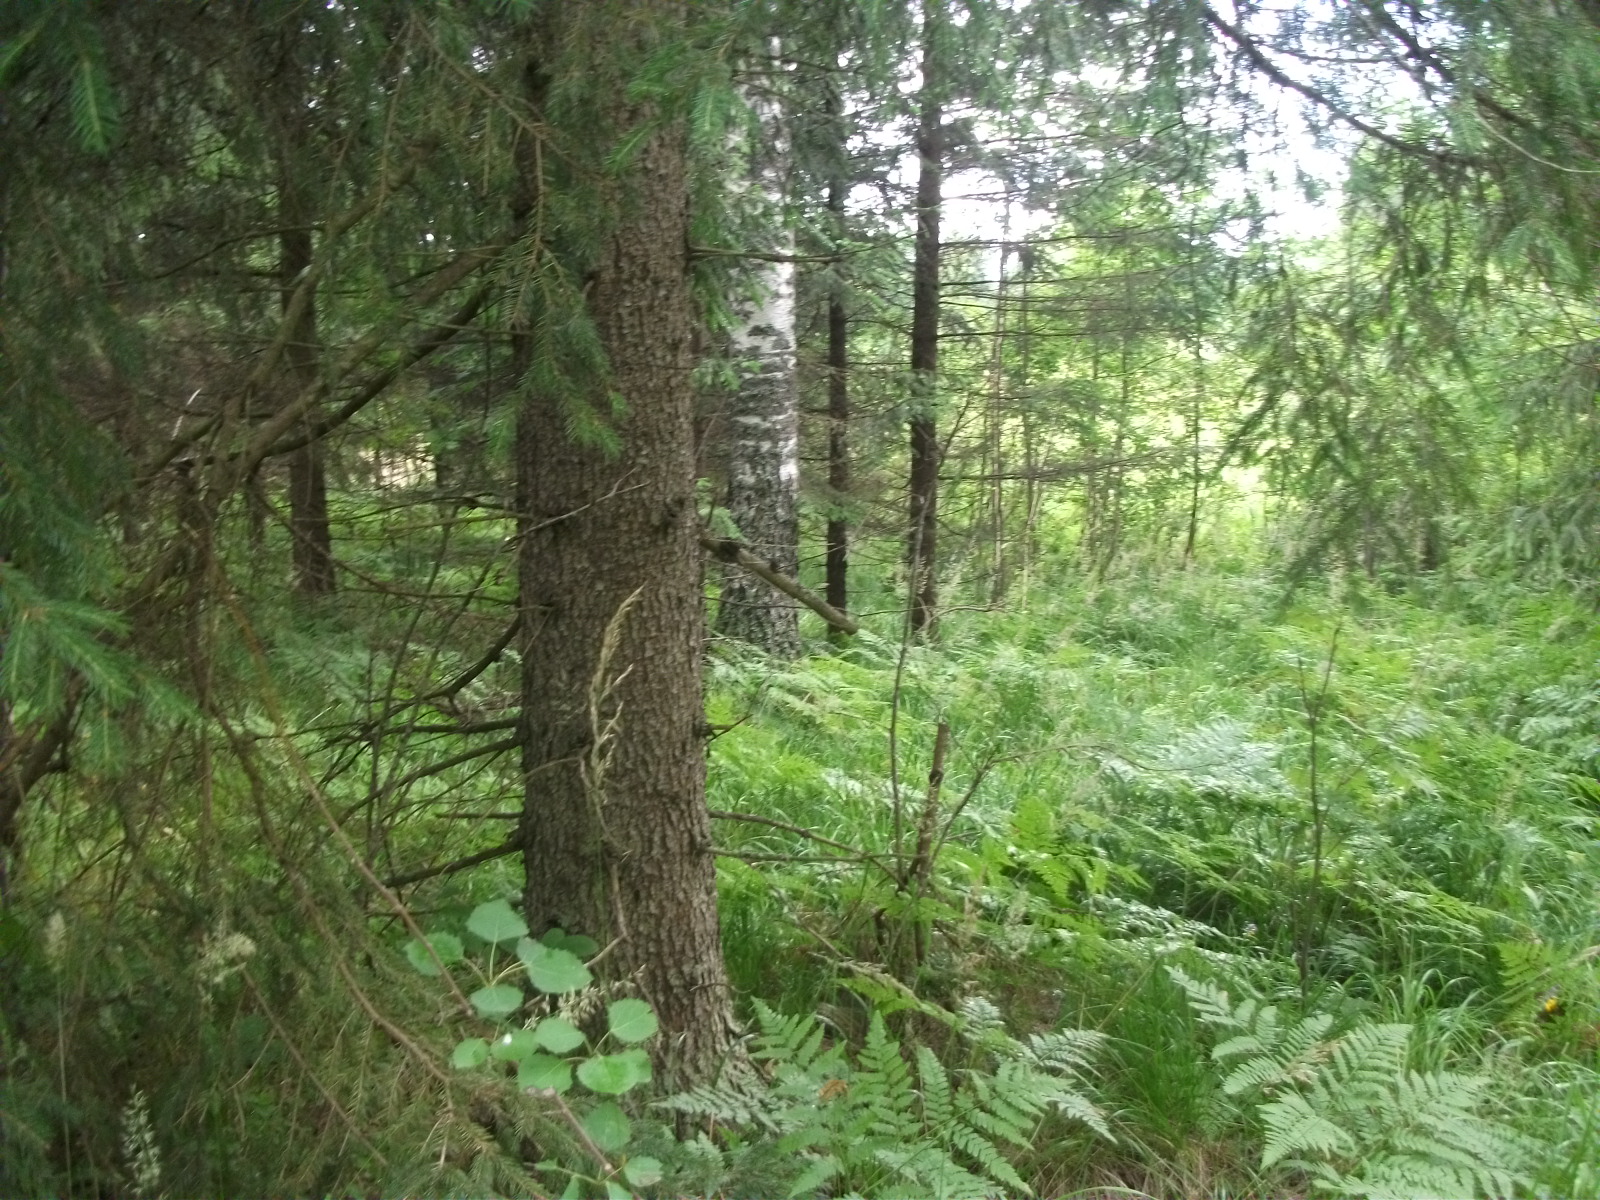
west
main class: Woodland
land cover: Spruce dominated mixed woodland
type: hemiboreal forest and nemoral coniferous forest and mixed broadleaved-coniferous forest
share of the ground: 50 - 75 %
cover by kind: coniferous forest trees 50 %, broadleaved forest trees 20 %, shrubs 15 %, herbaceous plants 15 %
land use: Forestry
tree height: > 5 m
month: July
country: LV
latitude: 56.9205
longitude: 25.8486
